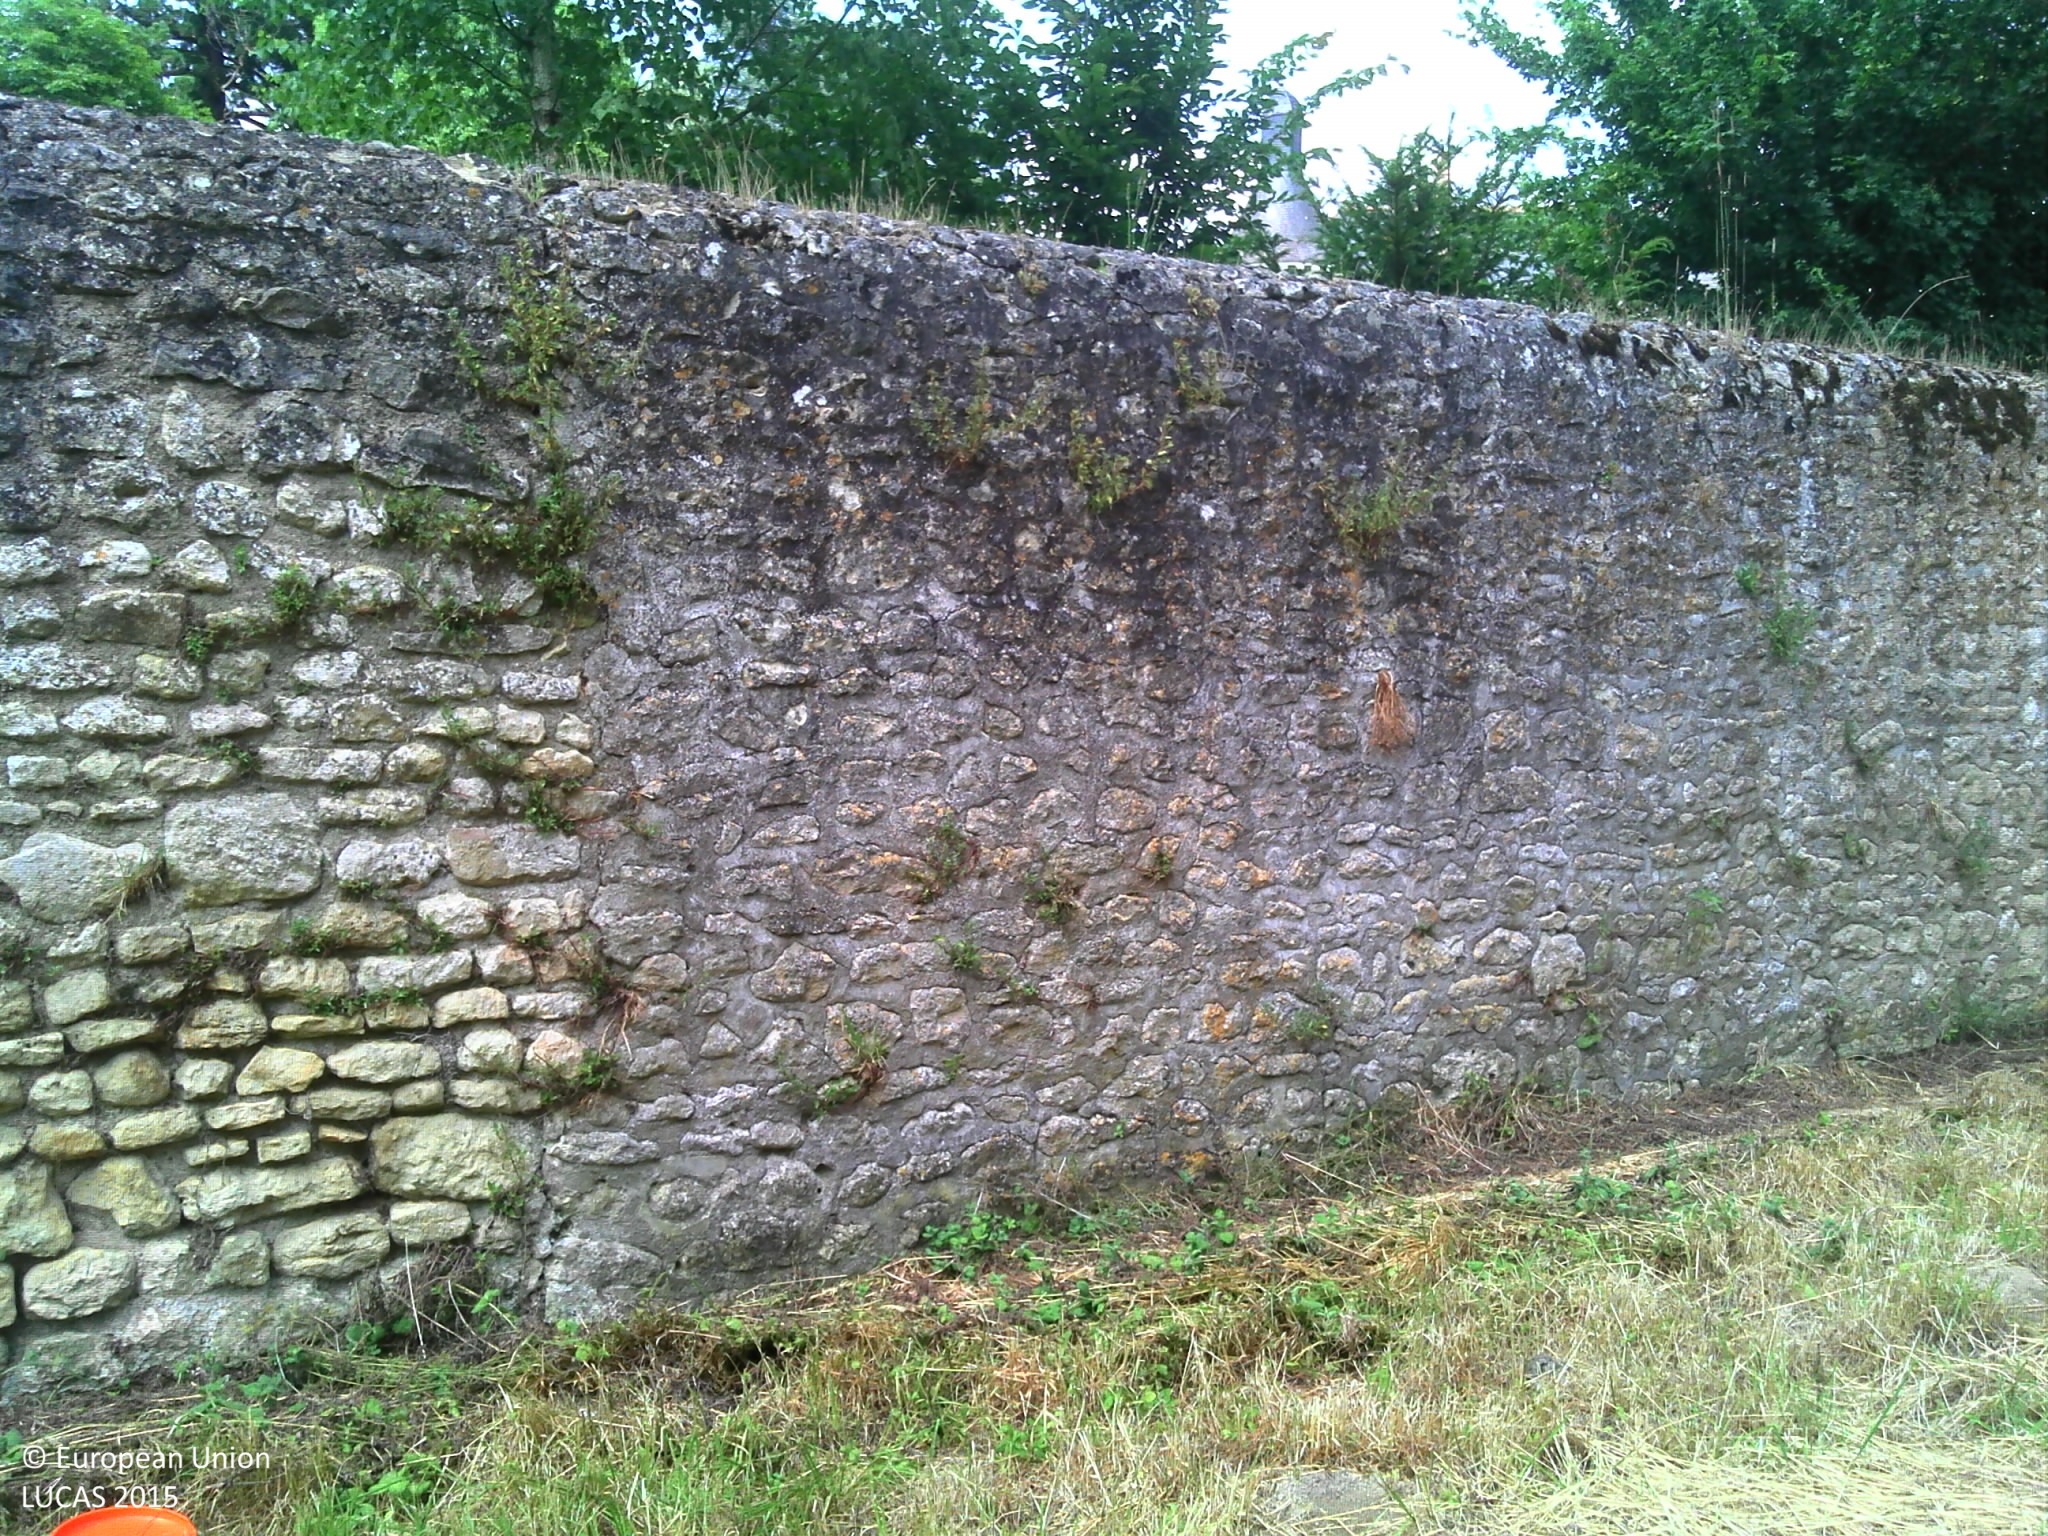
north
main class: Grassland
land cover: Grassland with sparse tree/shrub cover
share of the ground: > 75 %
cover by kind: herbaceous plants 95 %, broadleaved forest trees 5 %
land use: Residential
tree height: > 5 m
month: June
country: FR
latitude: 47.0818
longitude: 1.0677
